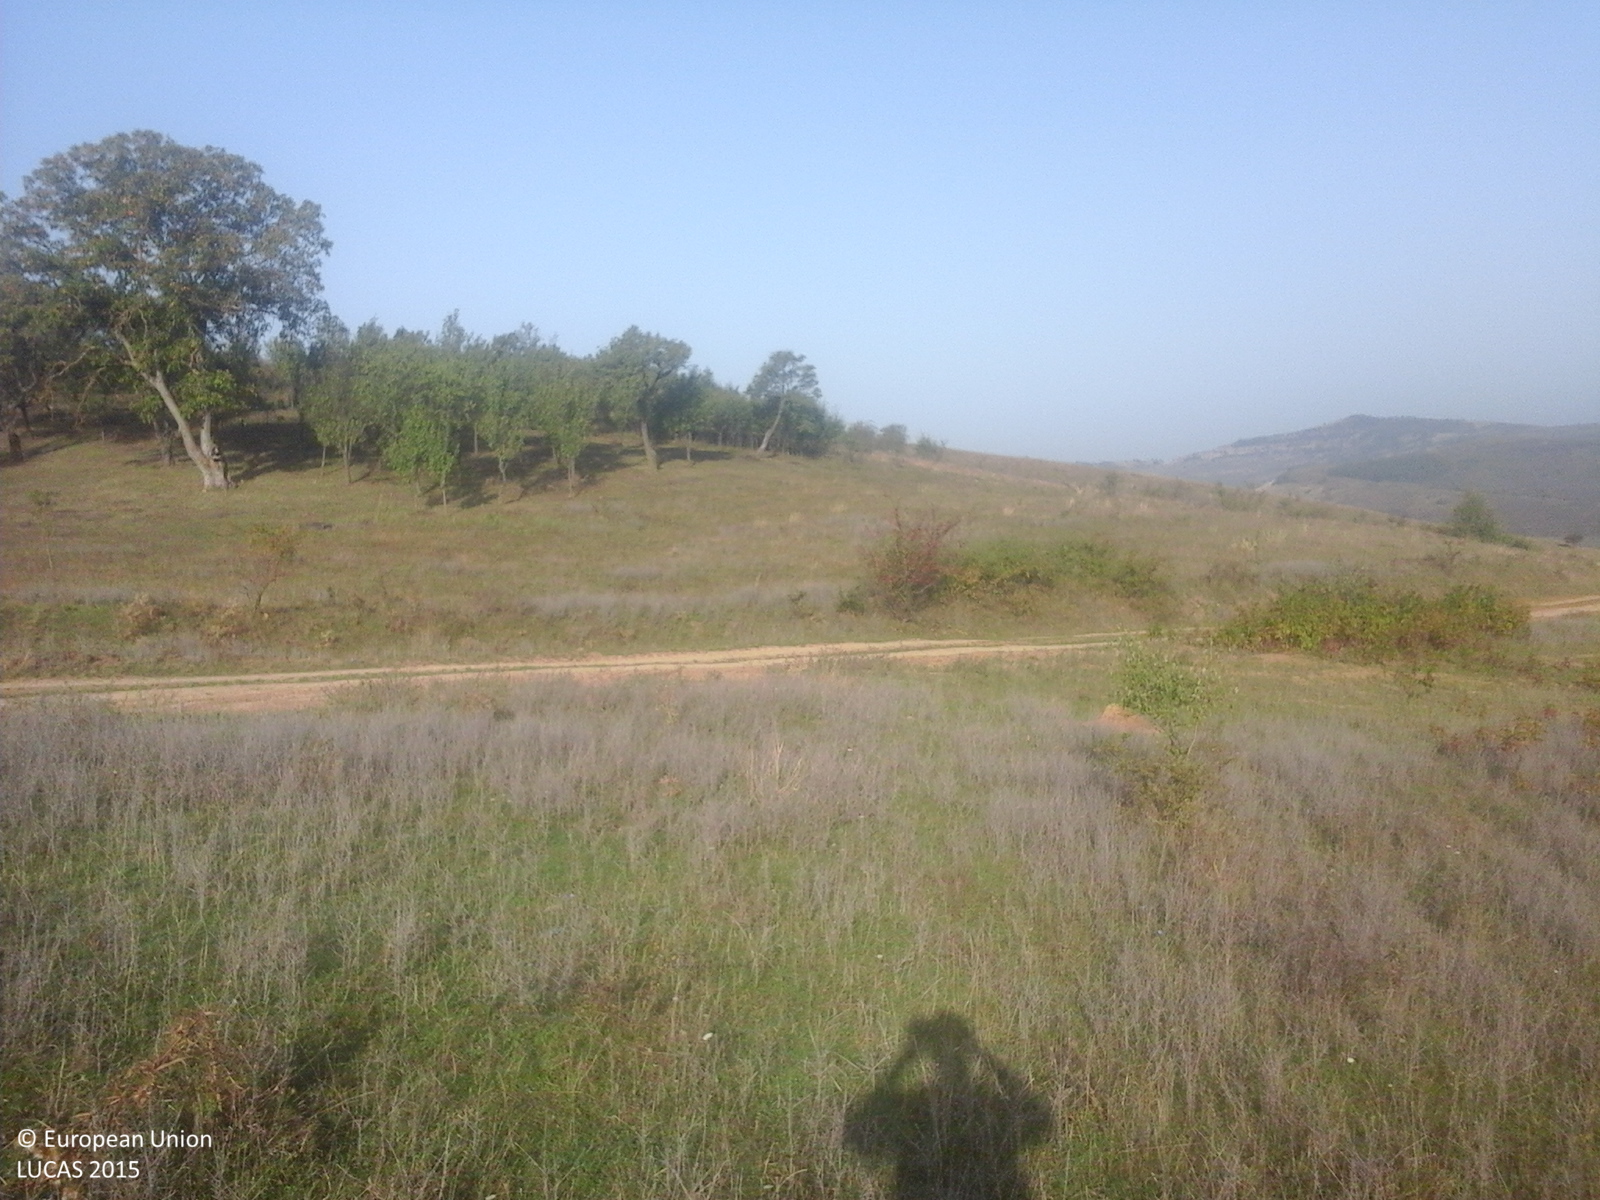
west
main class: Grassland
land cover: Spontaneously vegetated surfaces
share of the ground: > 75 %
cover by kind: herbaceous plants 100 %
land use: Agriculture (excluding fallow land and kitchen gardens)
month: September
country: RO
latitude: 46.9700
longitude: 23.9188
